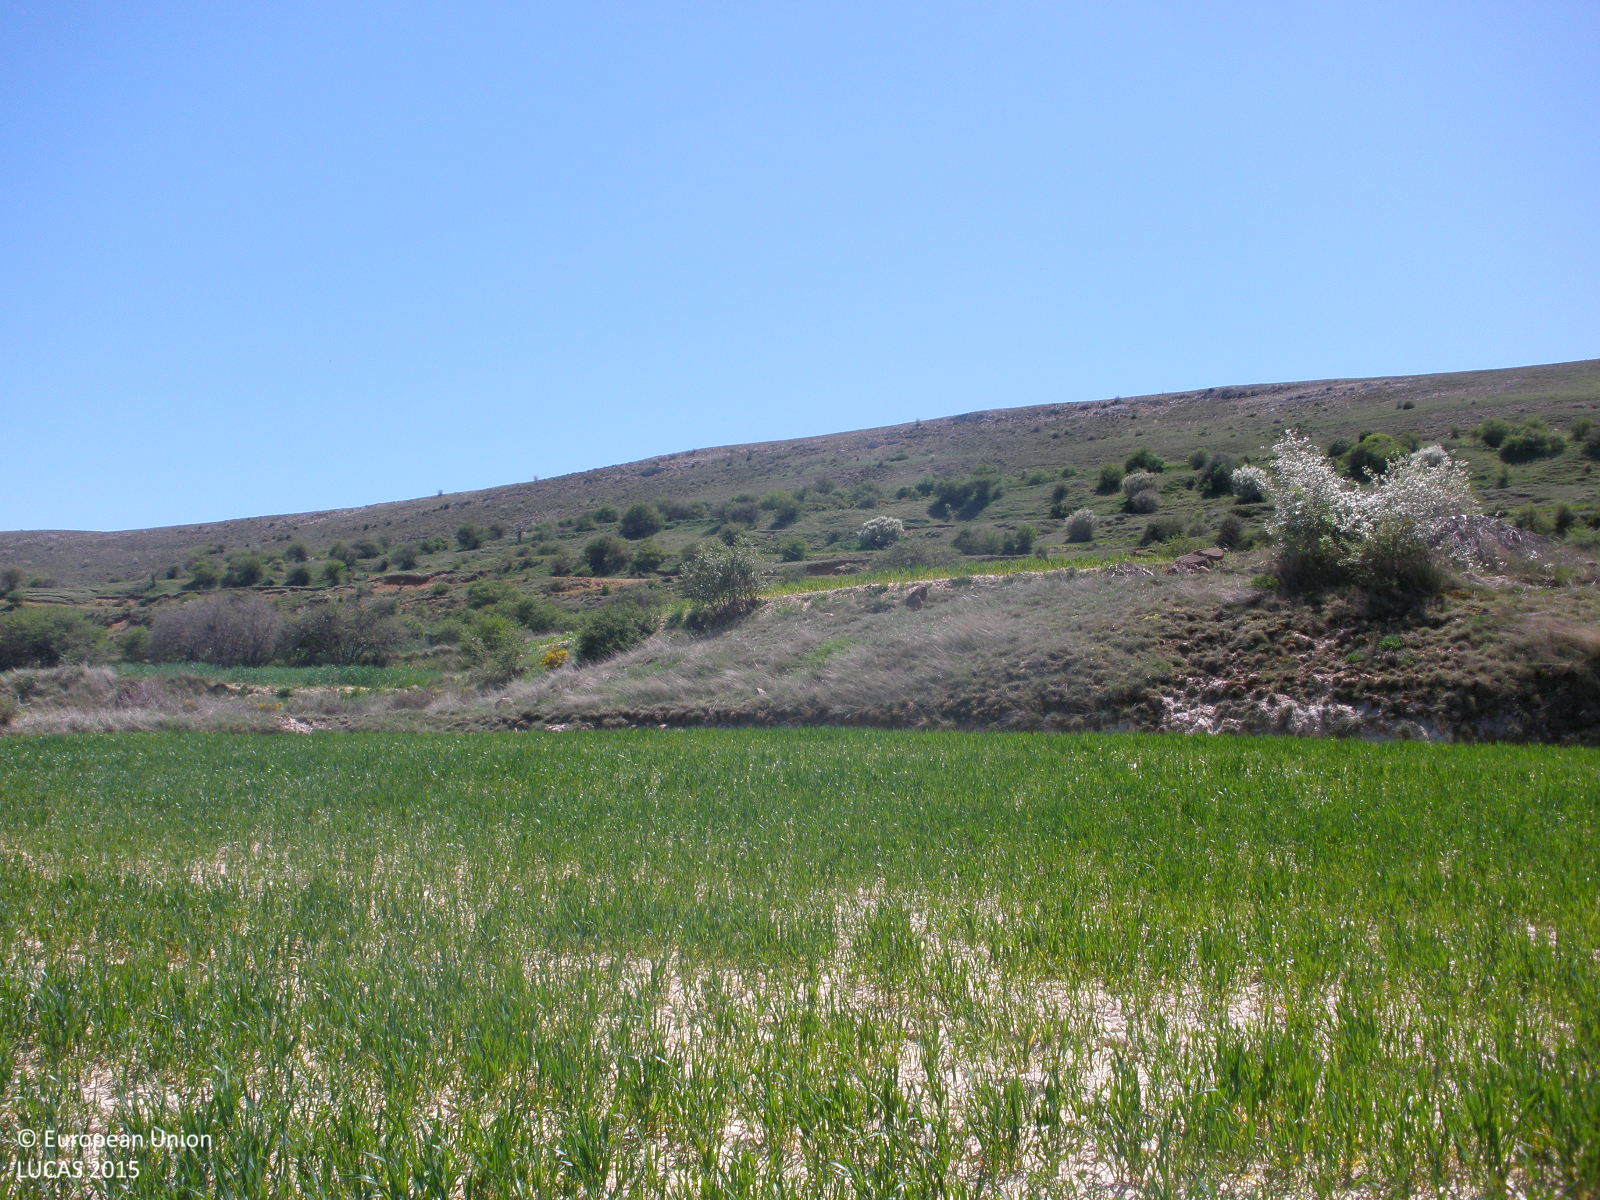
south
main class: Cropland
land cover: Durum wheat
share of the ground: 50 - 75 %
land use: Agriculture (excluding fallow land and kitchen gardens)
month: May
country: ES
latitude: 40.7577
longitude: -0.8514
